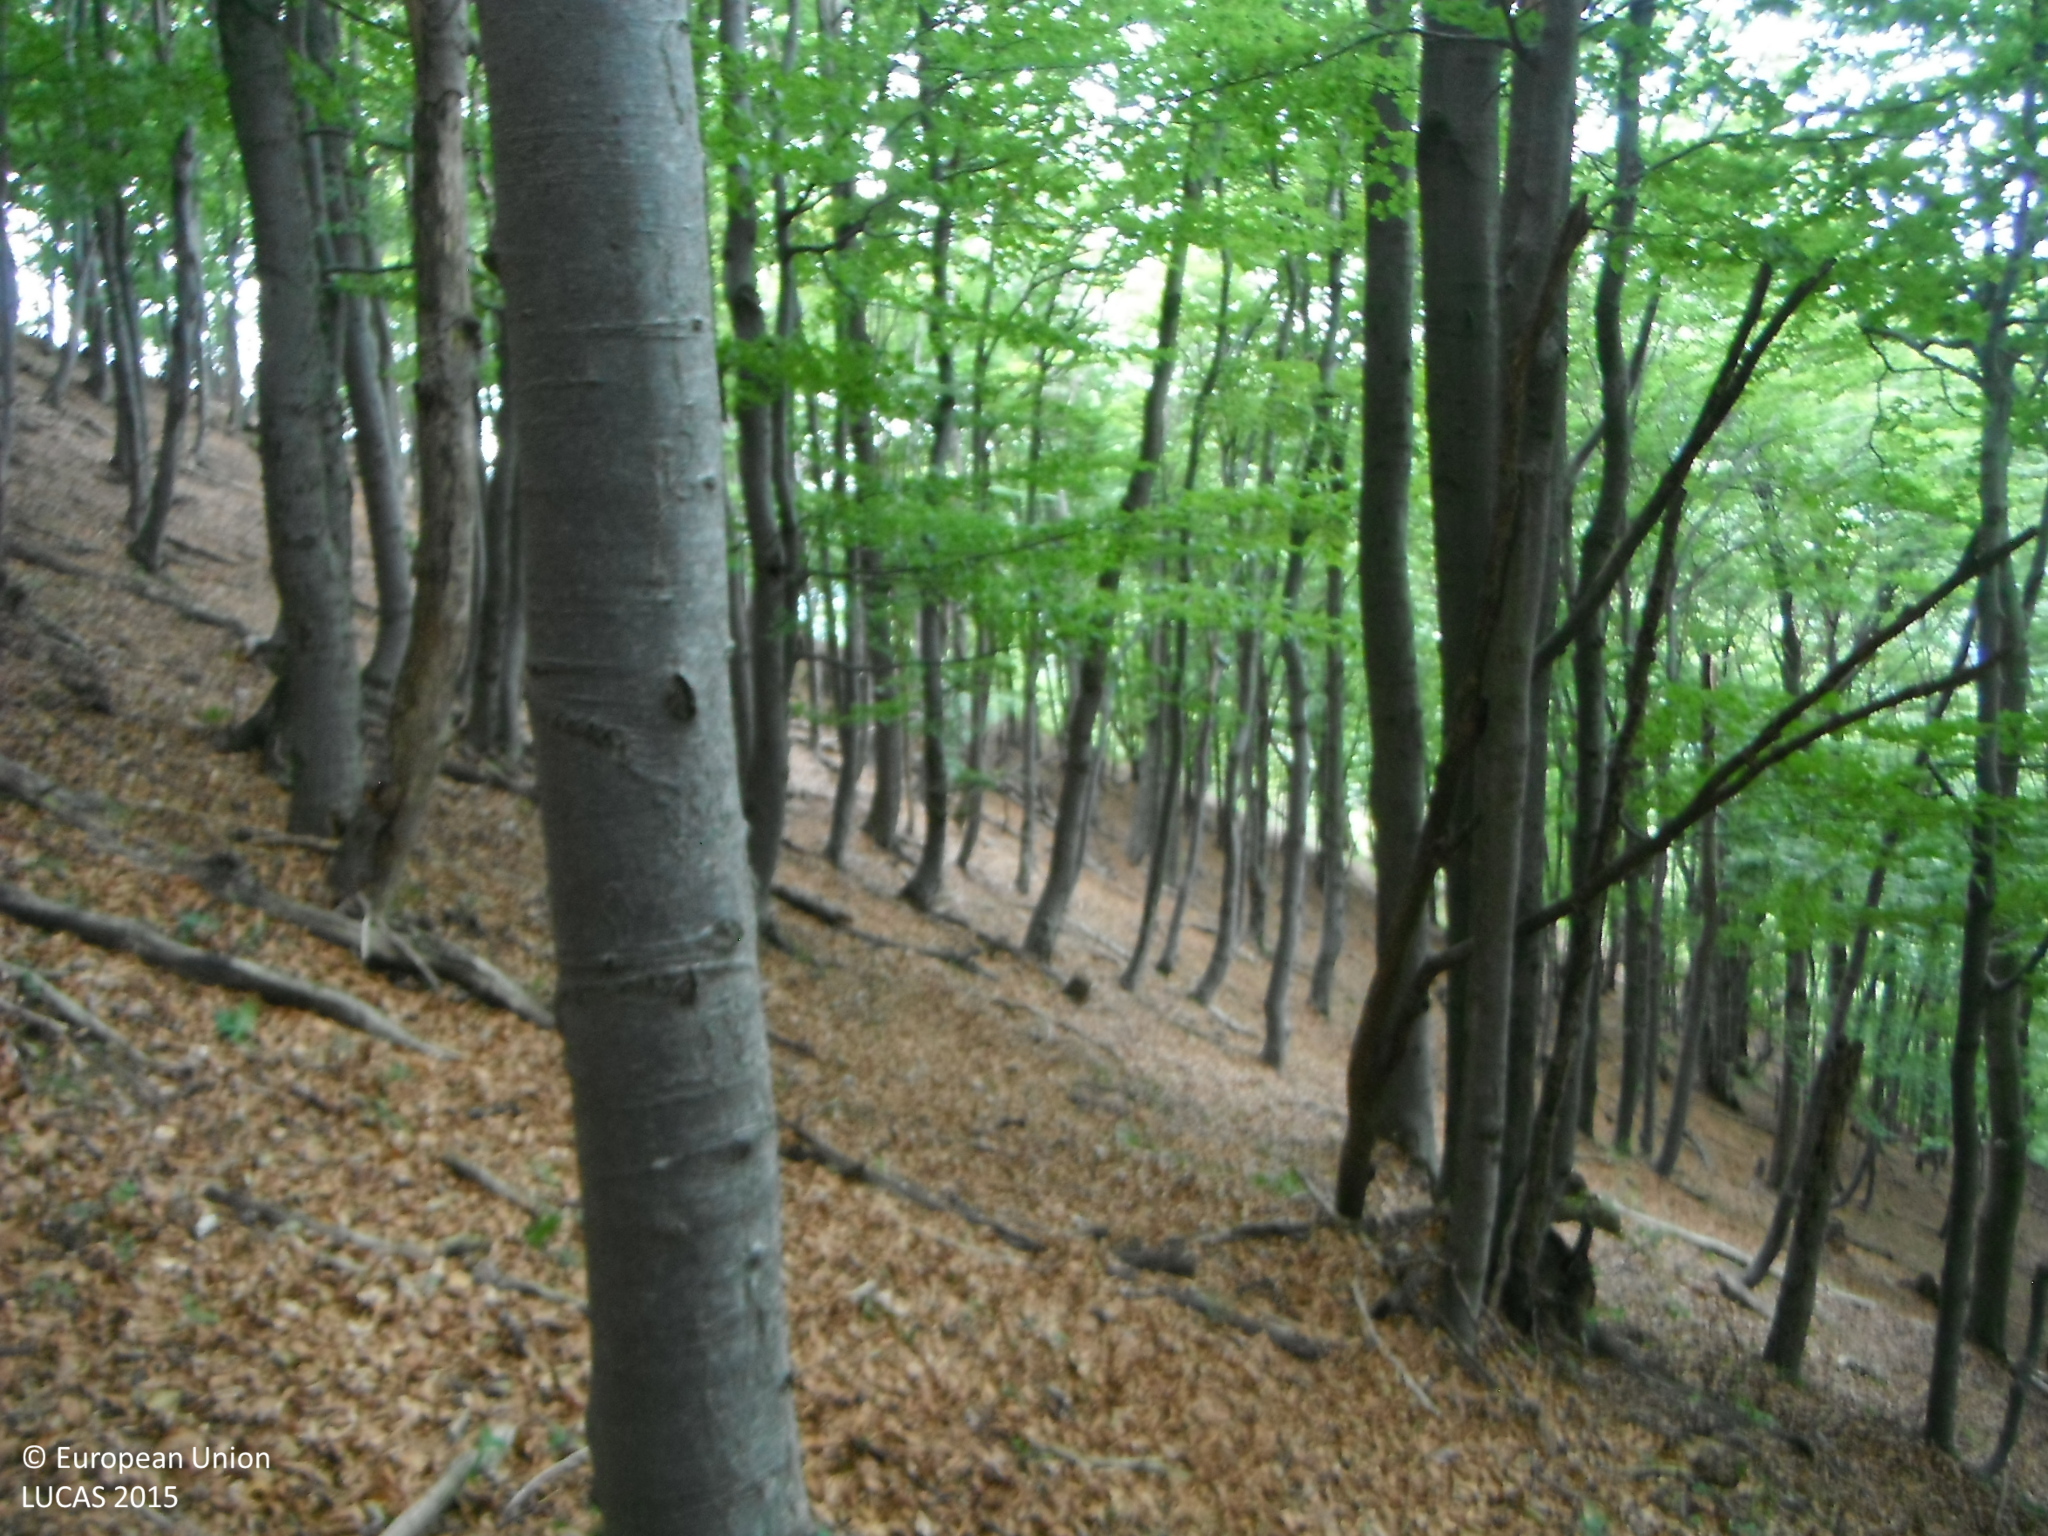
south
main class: Woodland
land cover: Broadleaved woodland
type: mountainous beech forest
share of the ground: > 75 %
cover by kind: broadleaved forest trees 85 %, herbaceous plants 5 %, consolidated bare surface 5 %
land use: Forestry
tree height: > 5 m
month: September
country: SK
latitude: 48.9189
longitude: 18.3547
